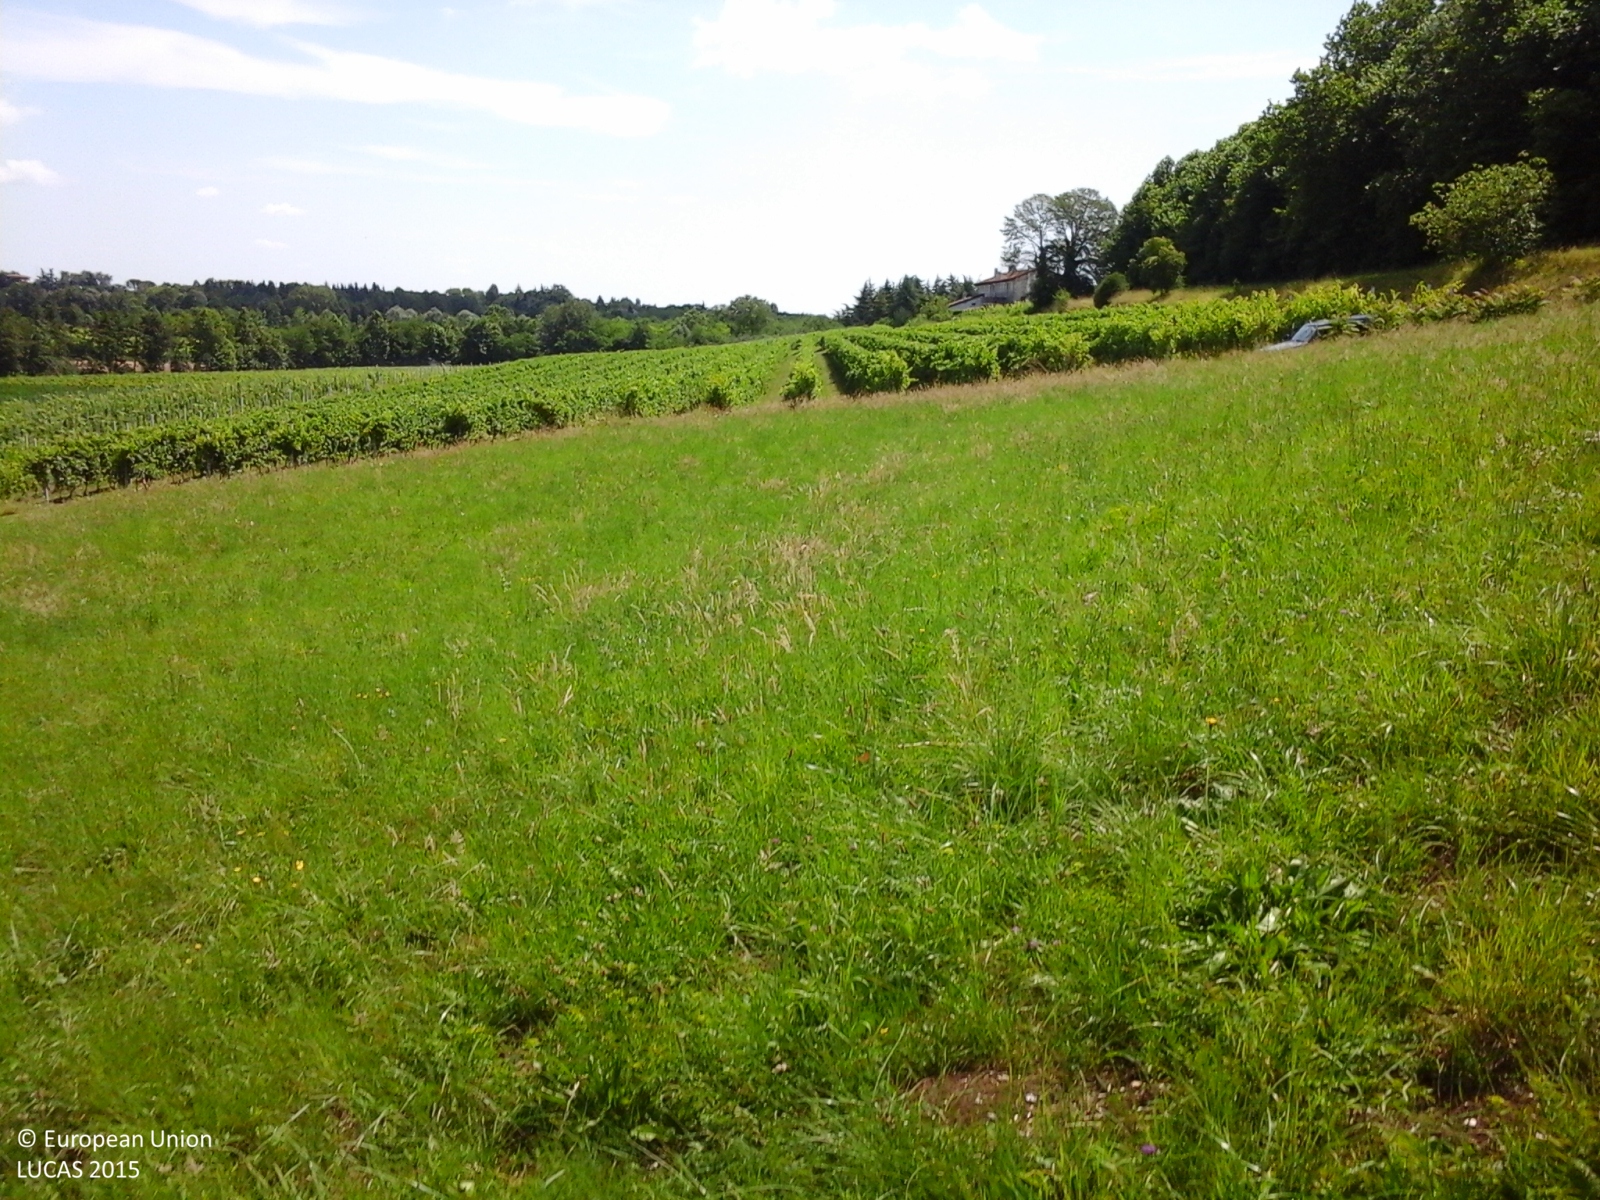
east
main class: Grassland
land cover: Grassland without tree/shrub cover
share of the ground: > 75 %
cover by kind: herbaceous plants 100 %
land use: Agriculture (excluding fallow land and kitchen gardens)
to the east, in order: Grassland without tree/shrub cover; Tracks; Vineyards; Tracks; Vineyards
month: June
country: IT
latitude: 45.9293
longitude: 12.3310
